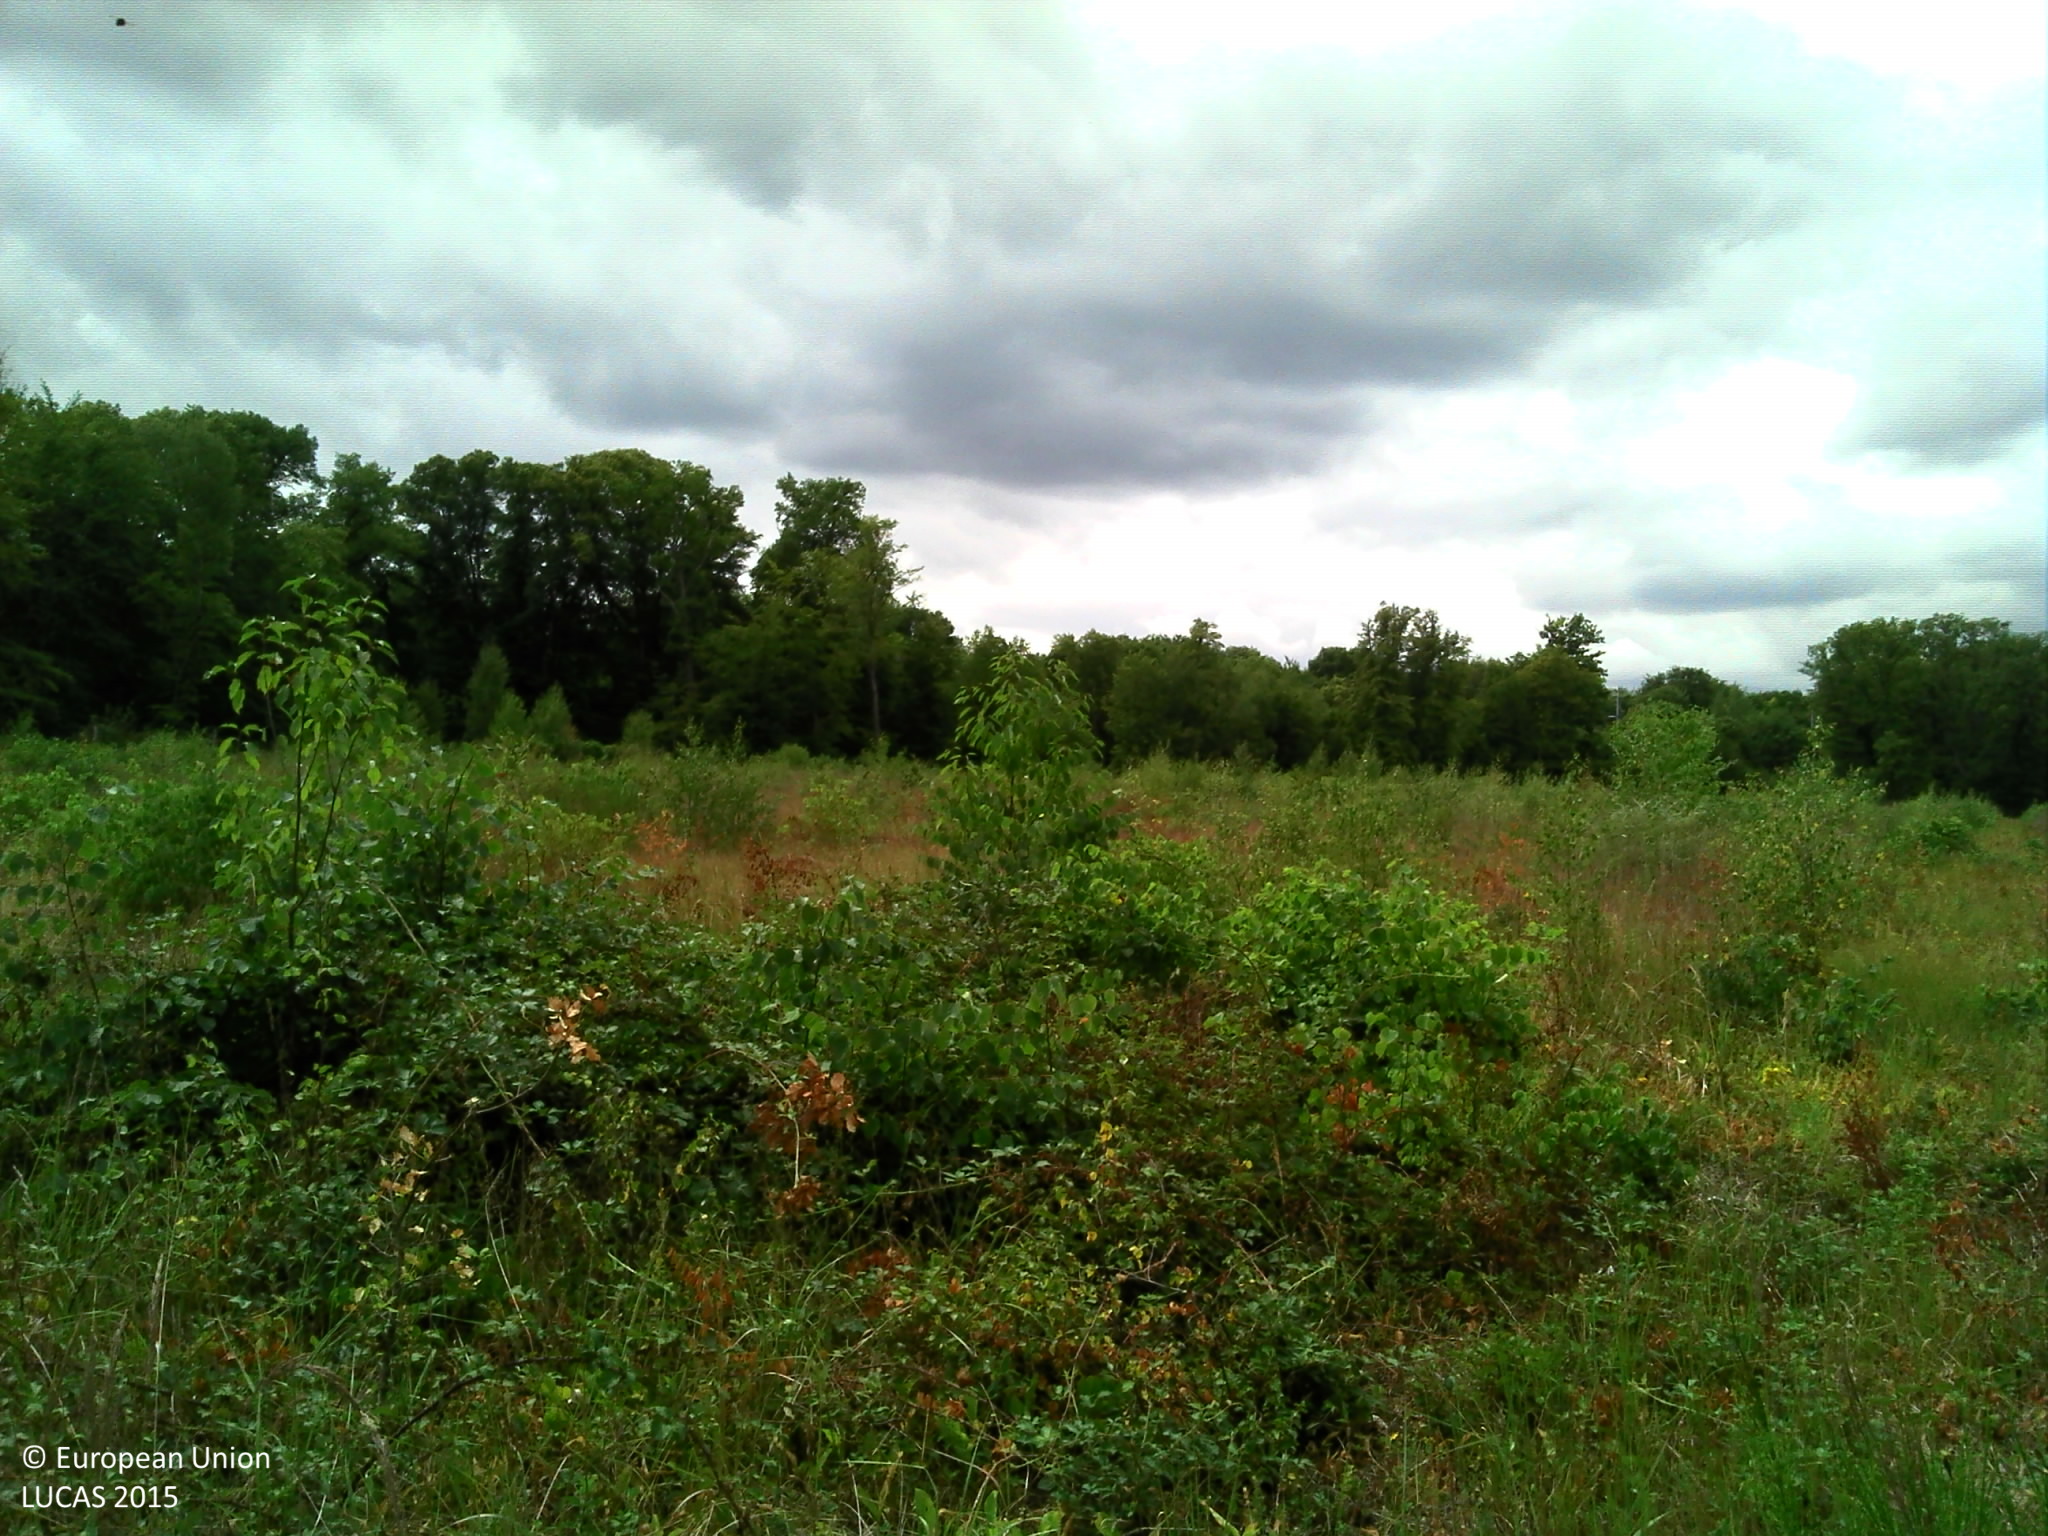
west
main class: Shrubland
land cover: Shrubland with sparse tree cover
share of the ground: > 75 %
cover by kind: shrubs 55 %, herbaceous plants 40 %, broadleaved forest trees 5 %
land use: Semi-natural and natural areas not in use
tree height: < 5 m
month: July
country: FR
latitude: 49.1416
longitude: 2.4901
